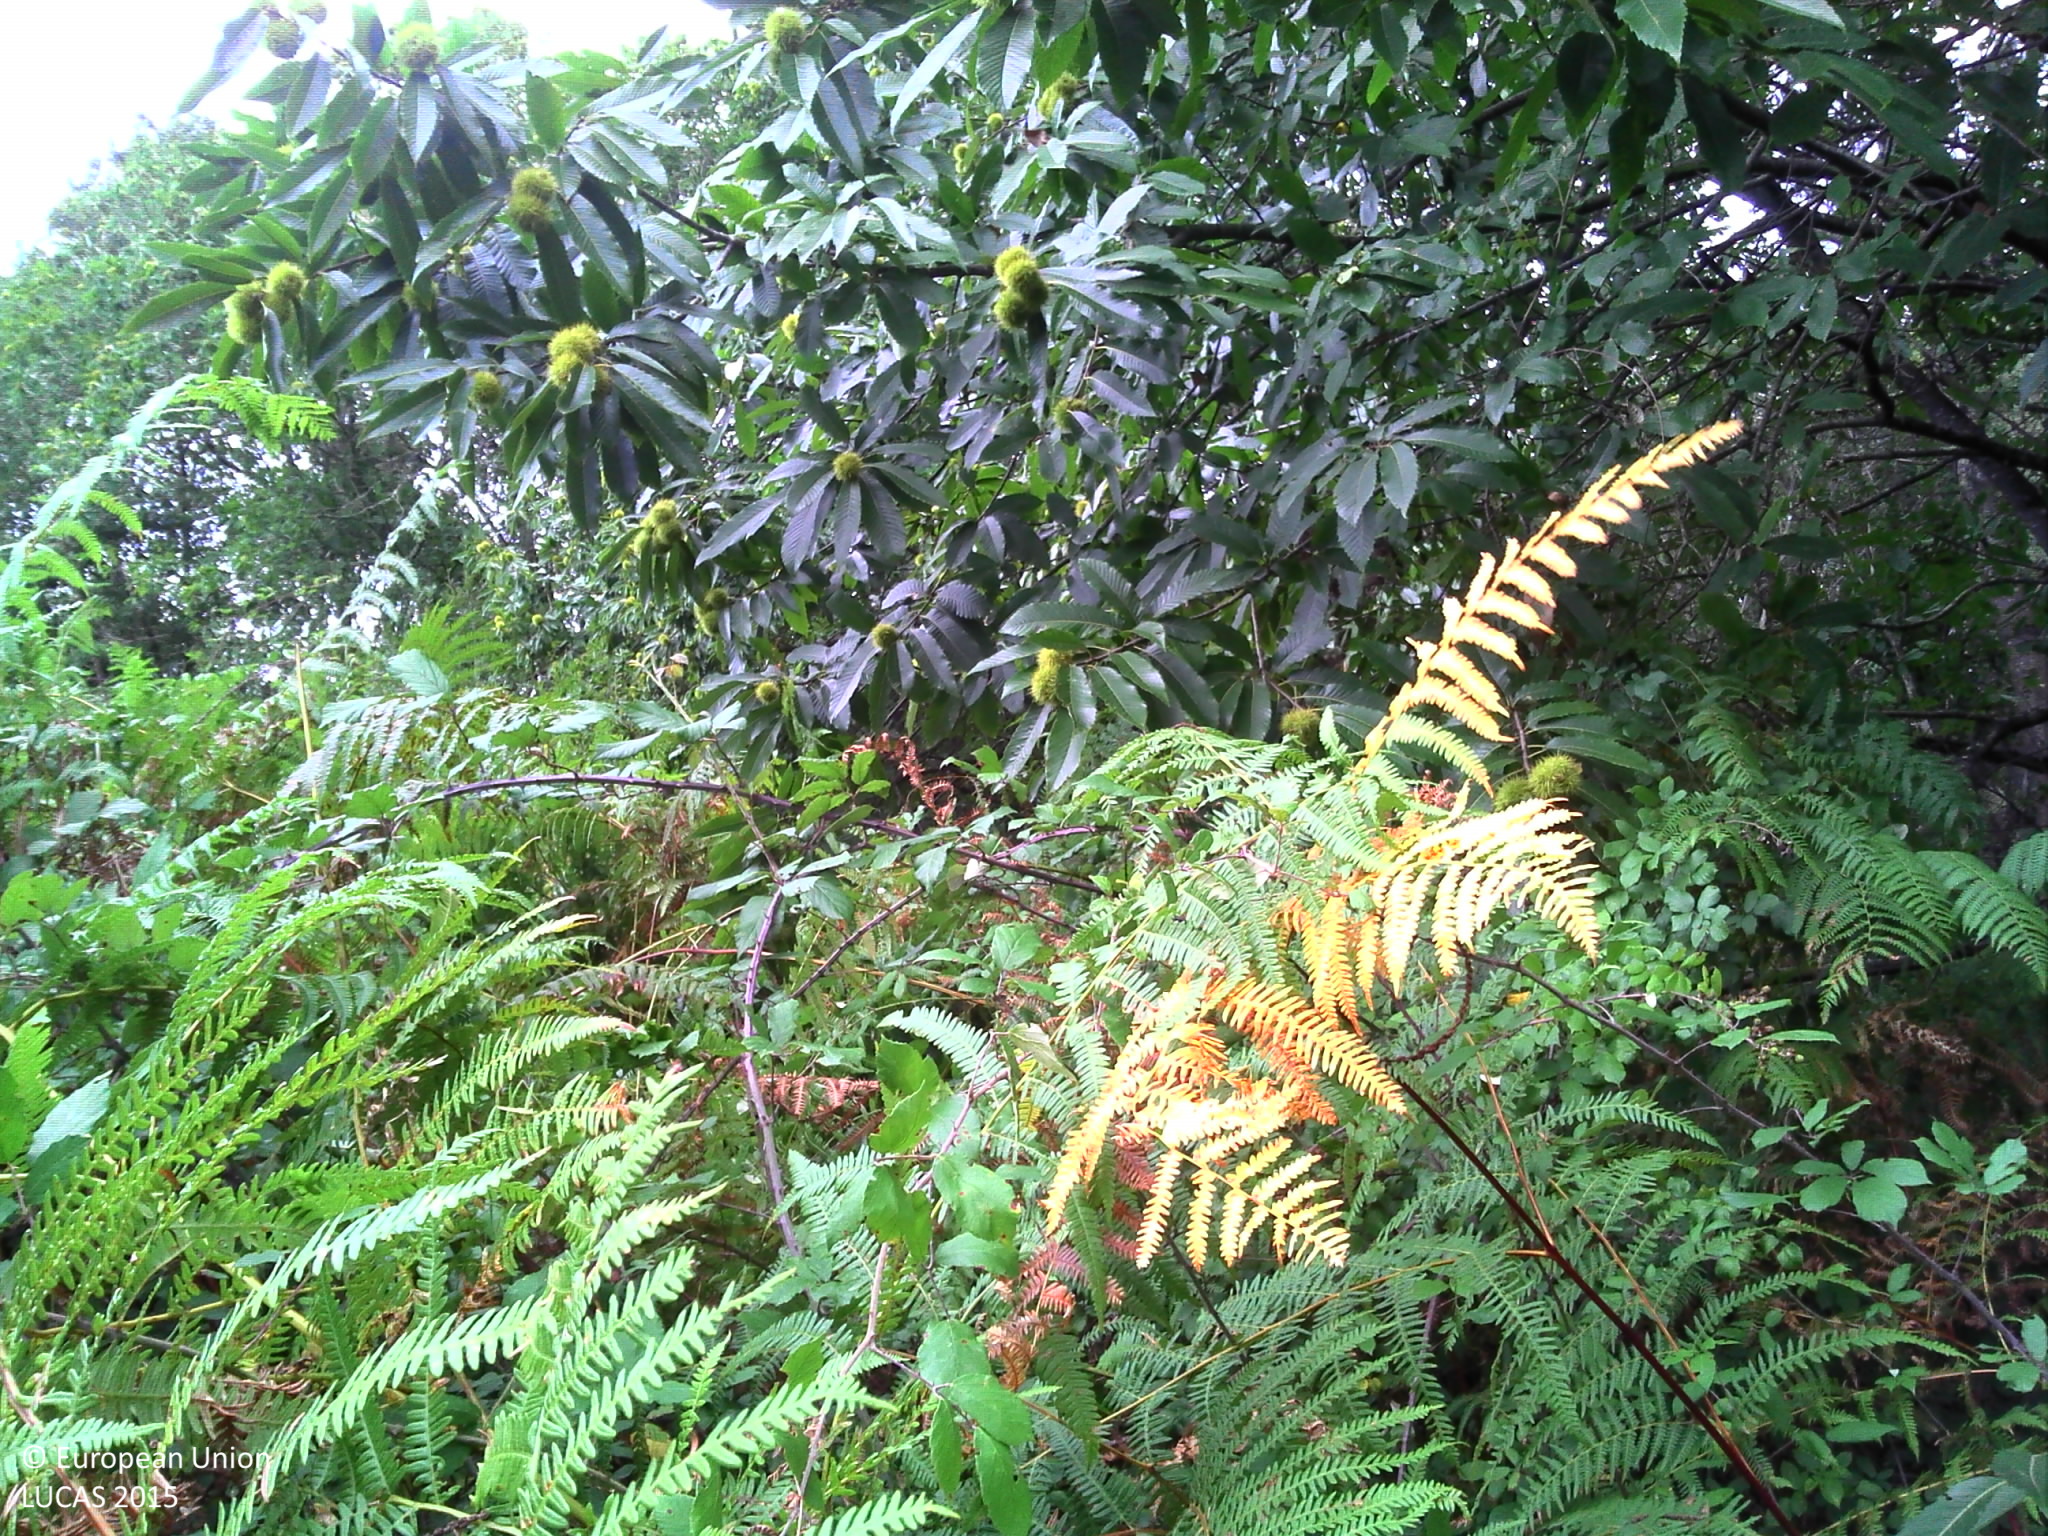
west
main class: Shrubland
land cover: Shrubland without tree cover
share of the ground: > 75 %
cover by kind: shrubs 50 %, herbaceous plants 50 %
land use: Abandoned areas
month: September
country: FR
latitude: 43.3381
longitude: -0.7288
